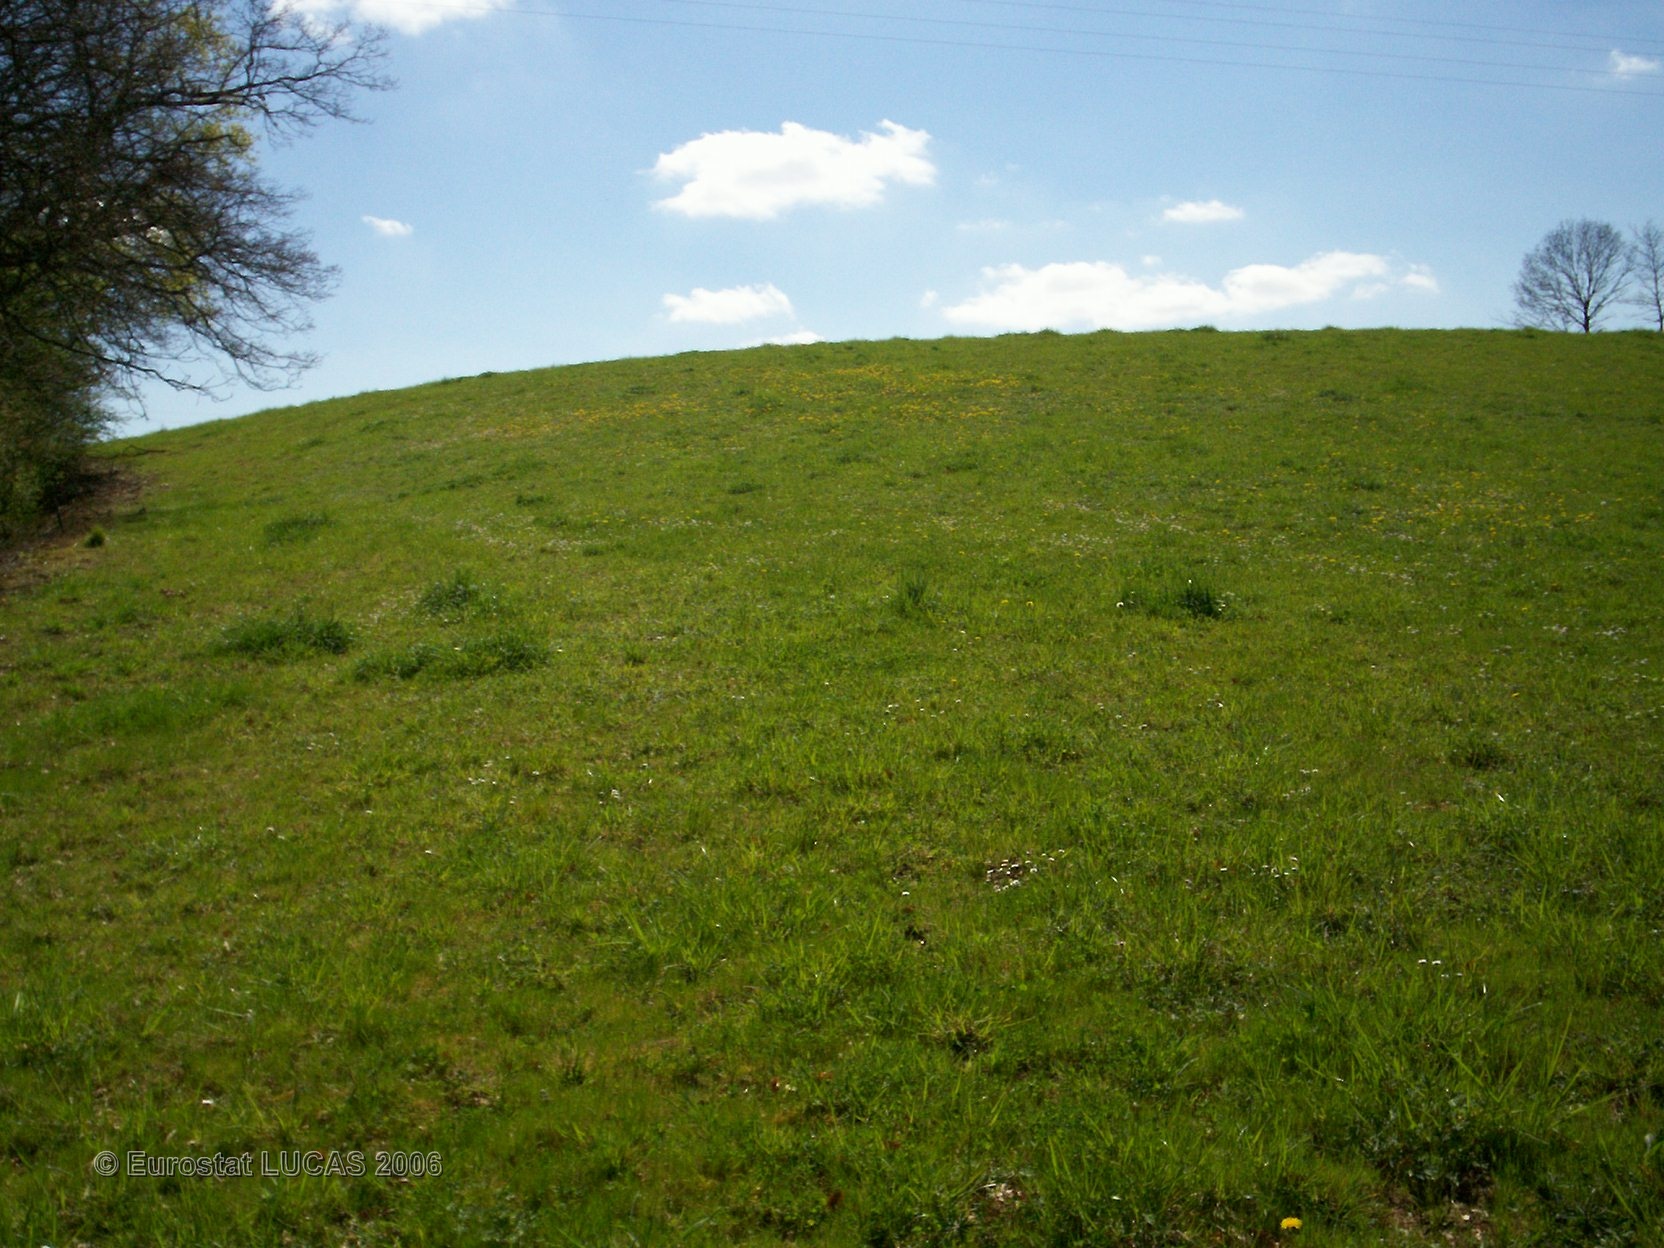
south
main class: Grassland
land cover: Grassland without tree/shrub cover
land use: Agriculture (excluding fallow land and kitchen gardens)
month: May
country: FR
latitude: 43.5412
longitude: 0.2065
